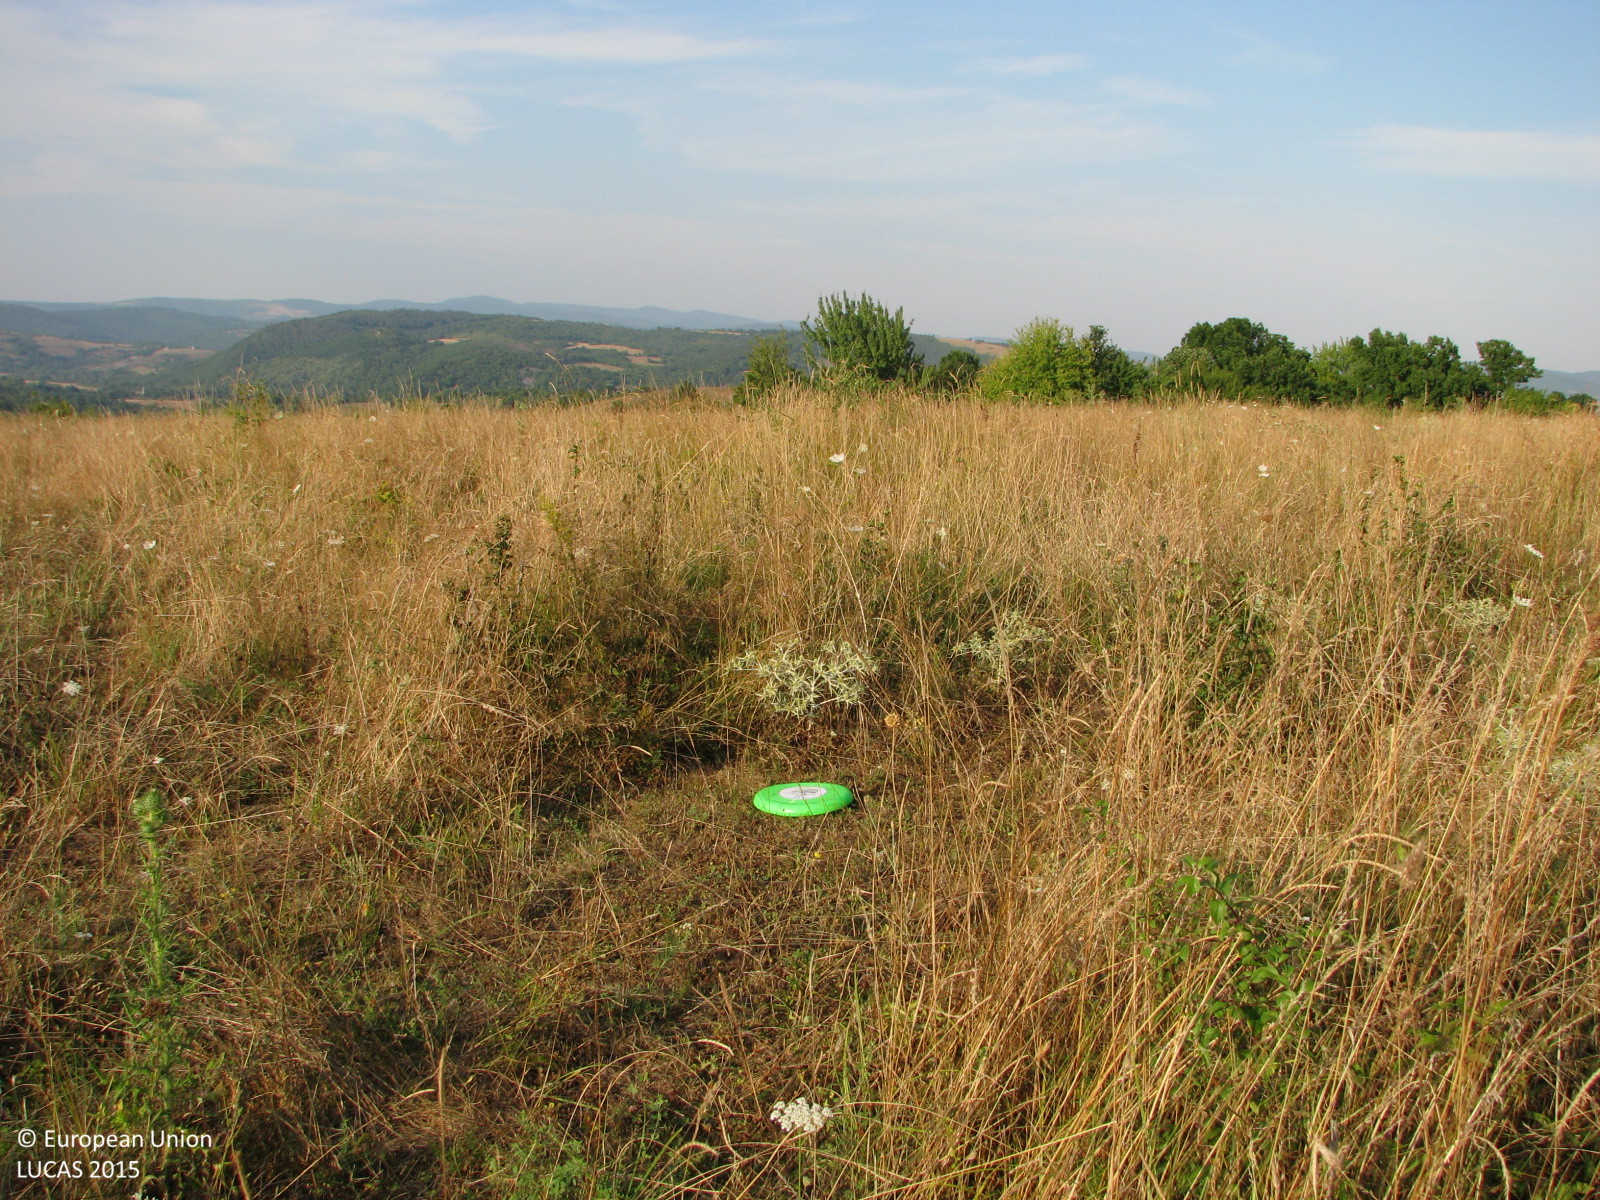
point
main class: Grassland
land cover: Grassland without tree/shrub cover
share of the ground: > 75 %
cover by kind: herbaceous plants 100 %
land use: Agriculture (excluding fallow land and kitchen gardens)
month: August
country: BG
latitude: 42.8929
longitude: 26.1427
